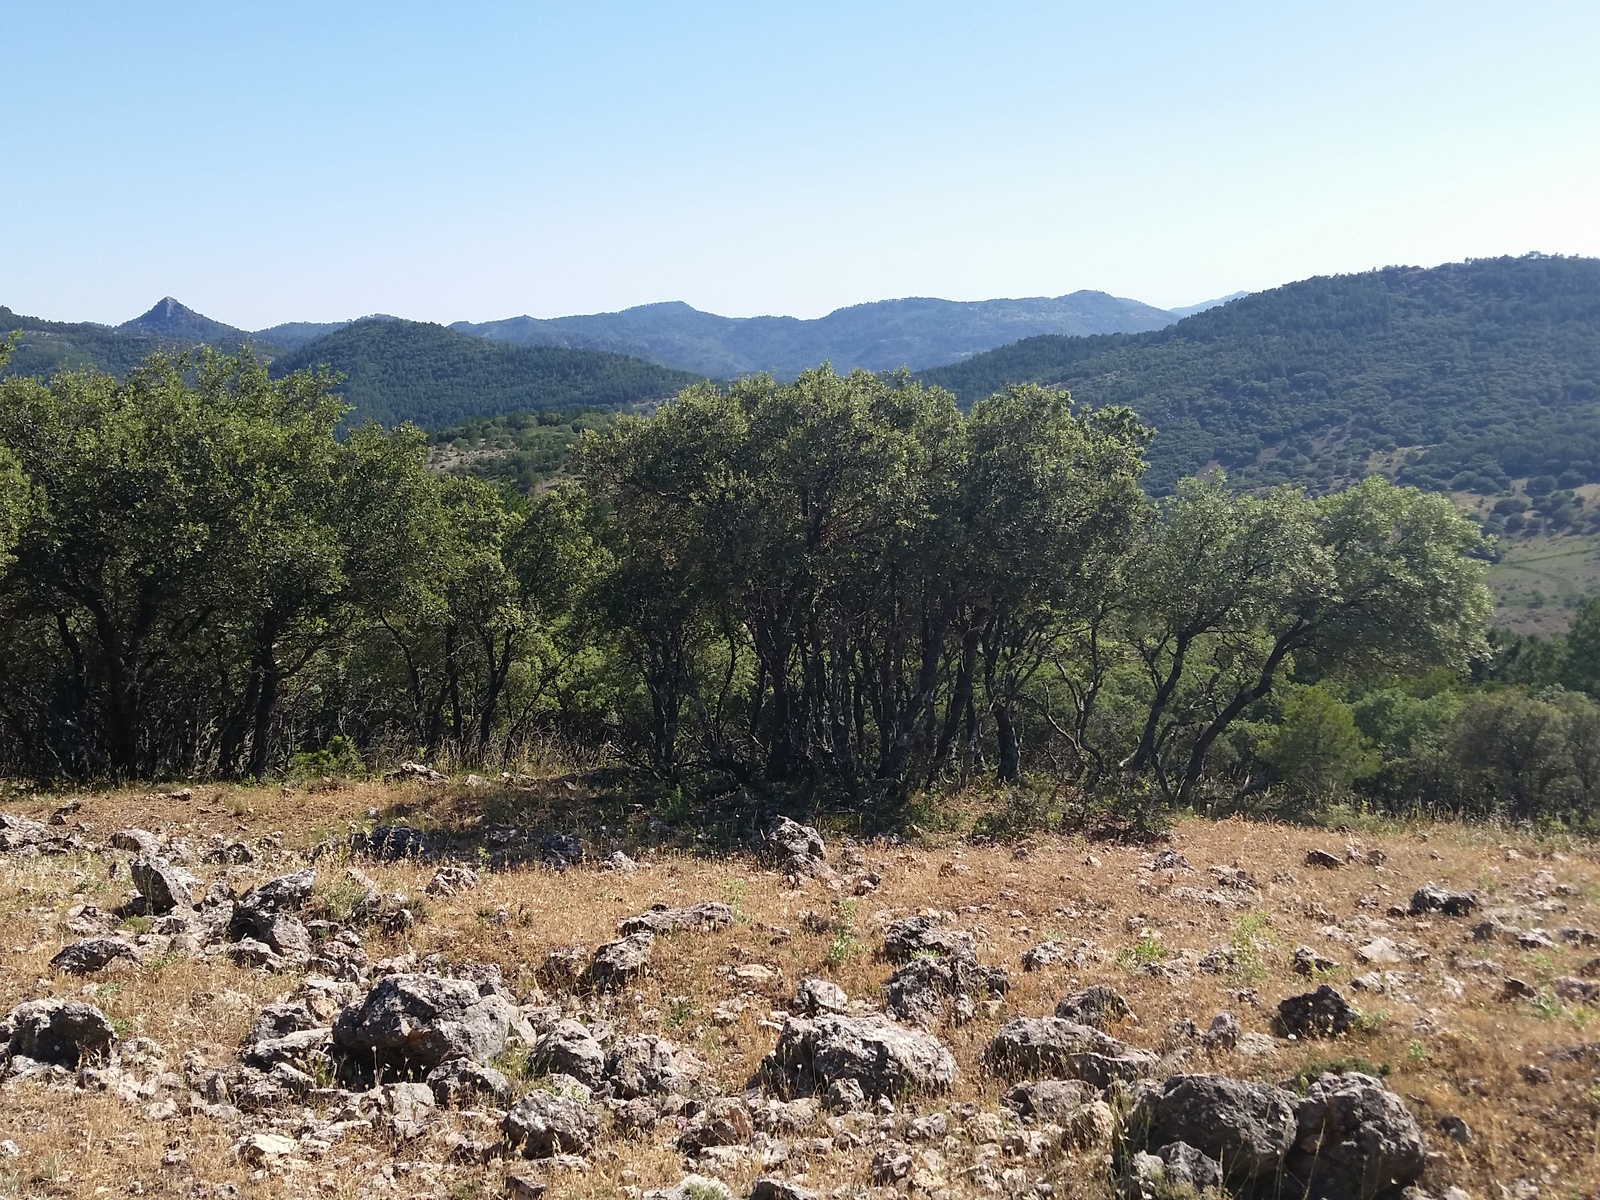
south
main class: Woodland
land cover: Pine dominated coniferous woodland
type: coniferous forest of the mediterranean region
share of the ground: 50 - 75 %
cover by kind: coniferous forest trees 60 %, shrubs 30 %, herbaceous plants 5 %, consolidated bare surface 5 %
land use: Semi-natural and natural areas not in use
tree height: > 5 m
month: June
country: ES
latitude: 38.5414
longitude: -2.5630
